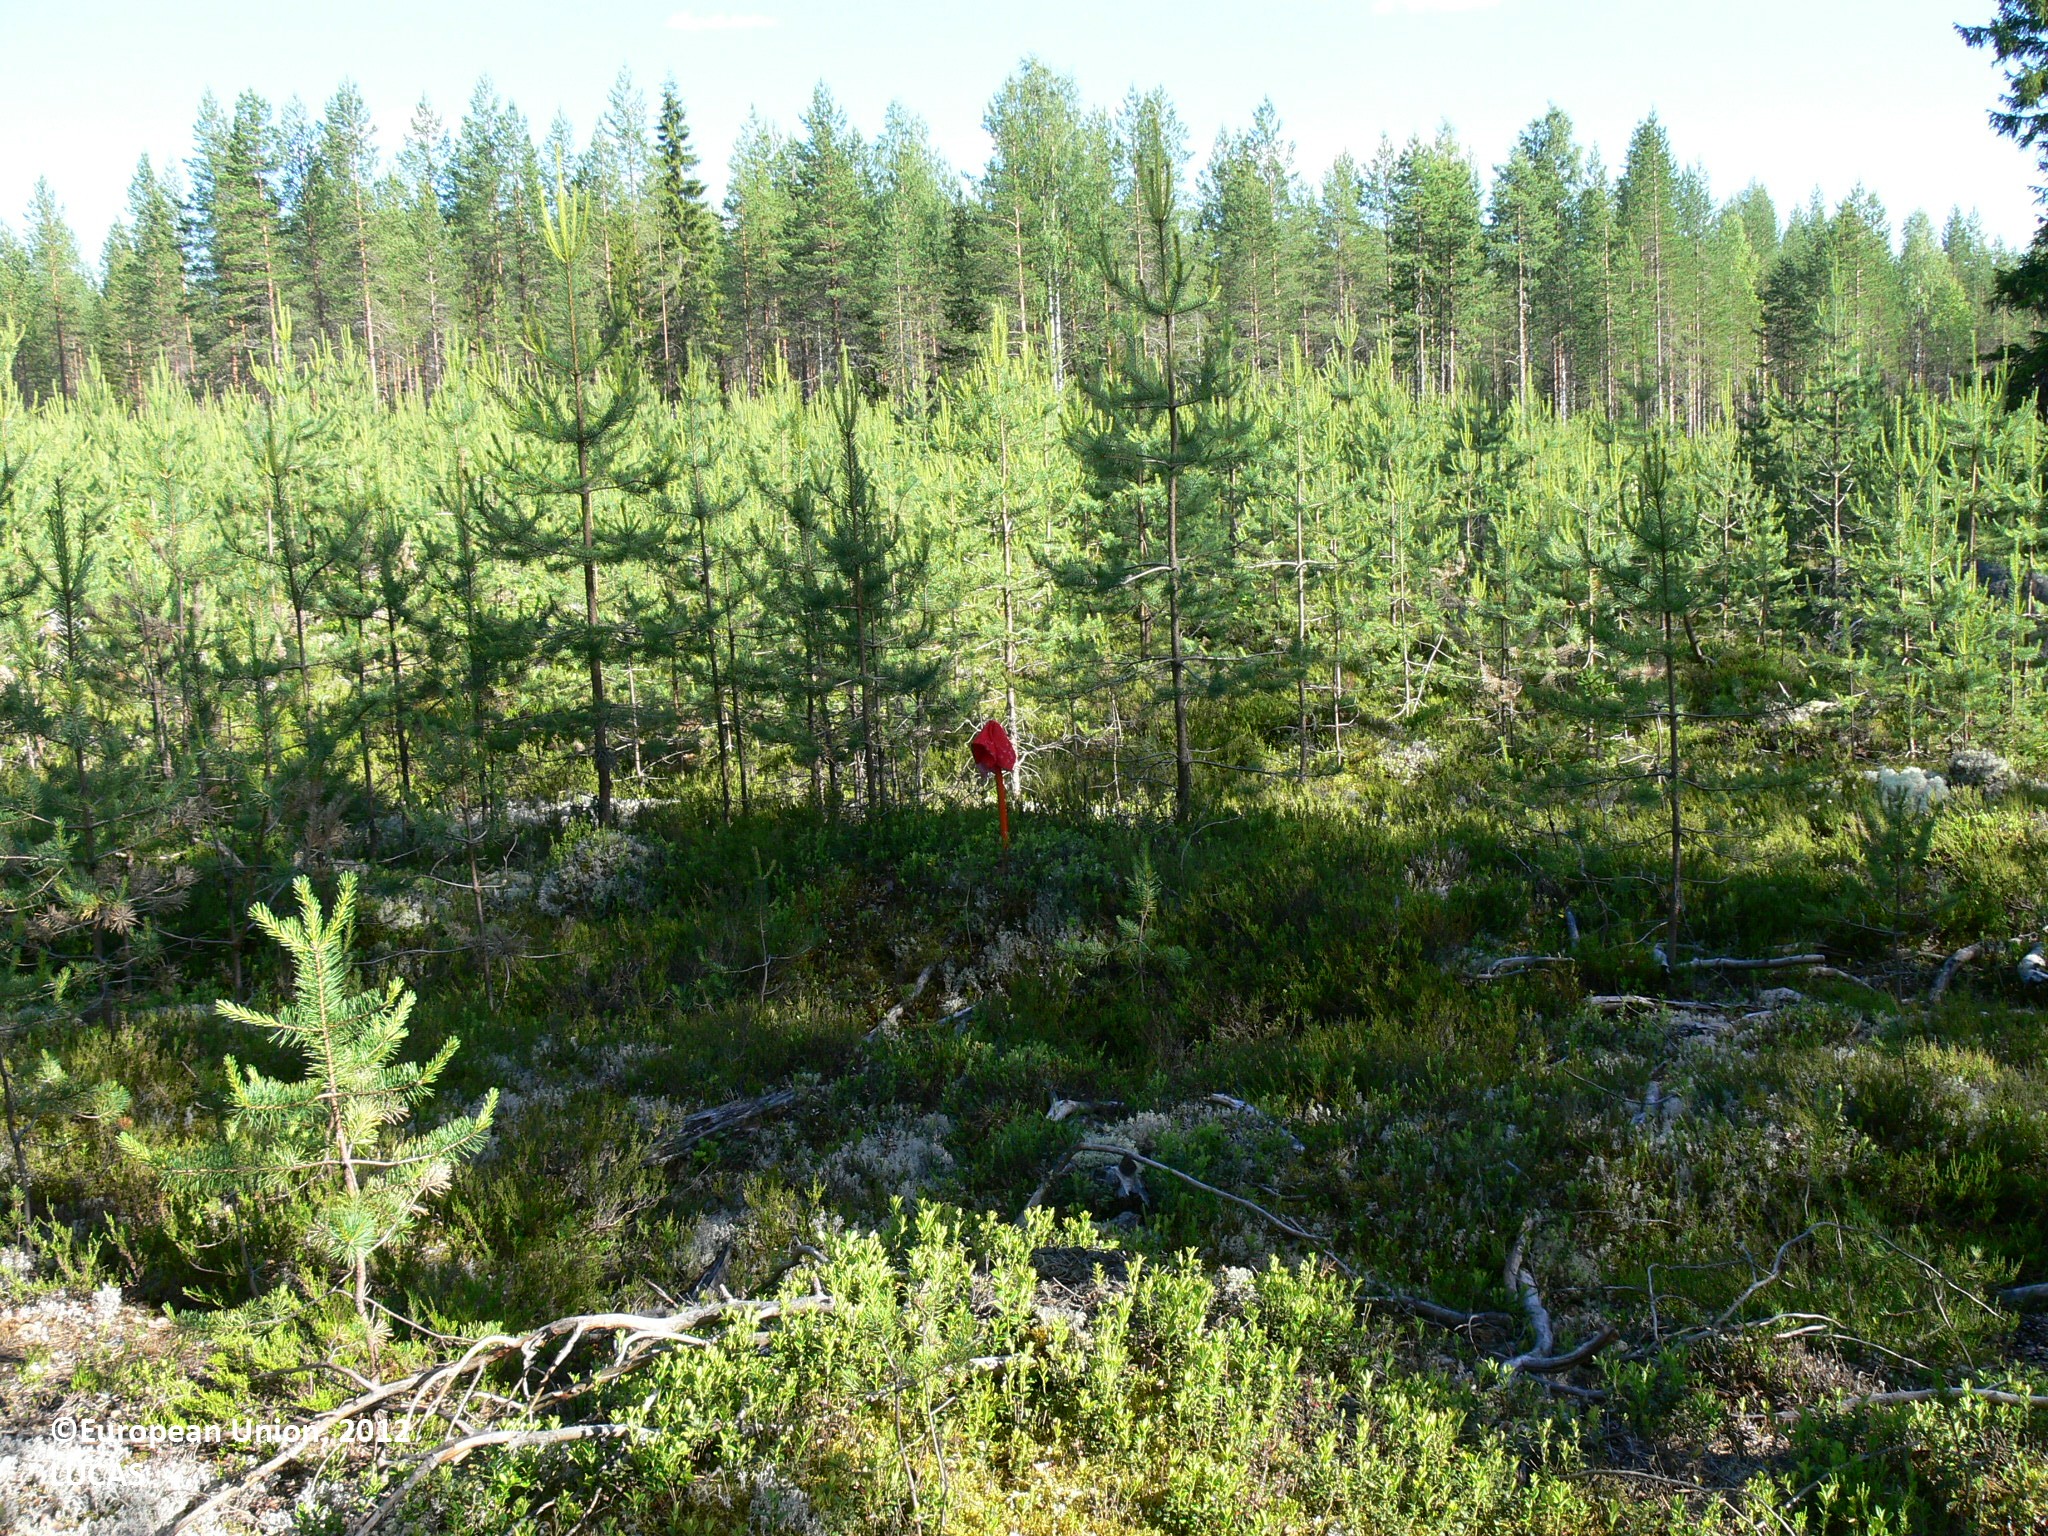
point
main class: Woodland
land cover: Pine dominated coniferous woodland
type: boreal forest
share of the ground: 10 - 25 %
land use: Forestry
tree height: < 5 m
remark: Clear cut
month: July
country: FI
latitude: 63.0968
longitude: 31.1238
